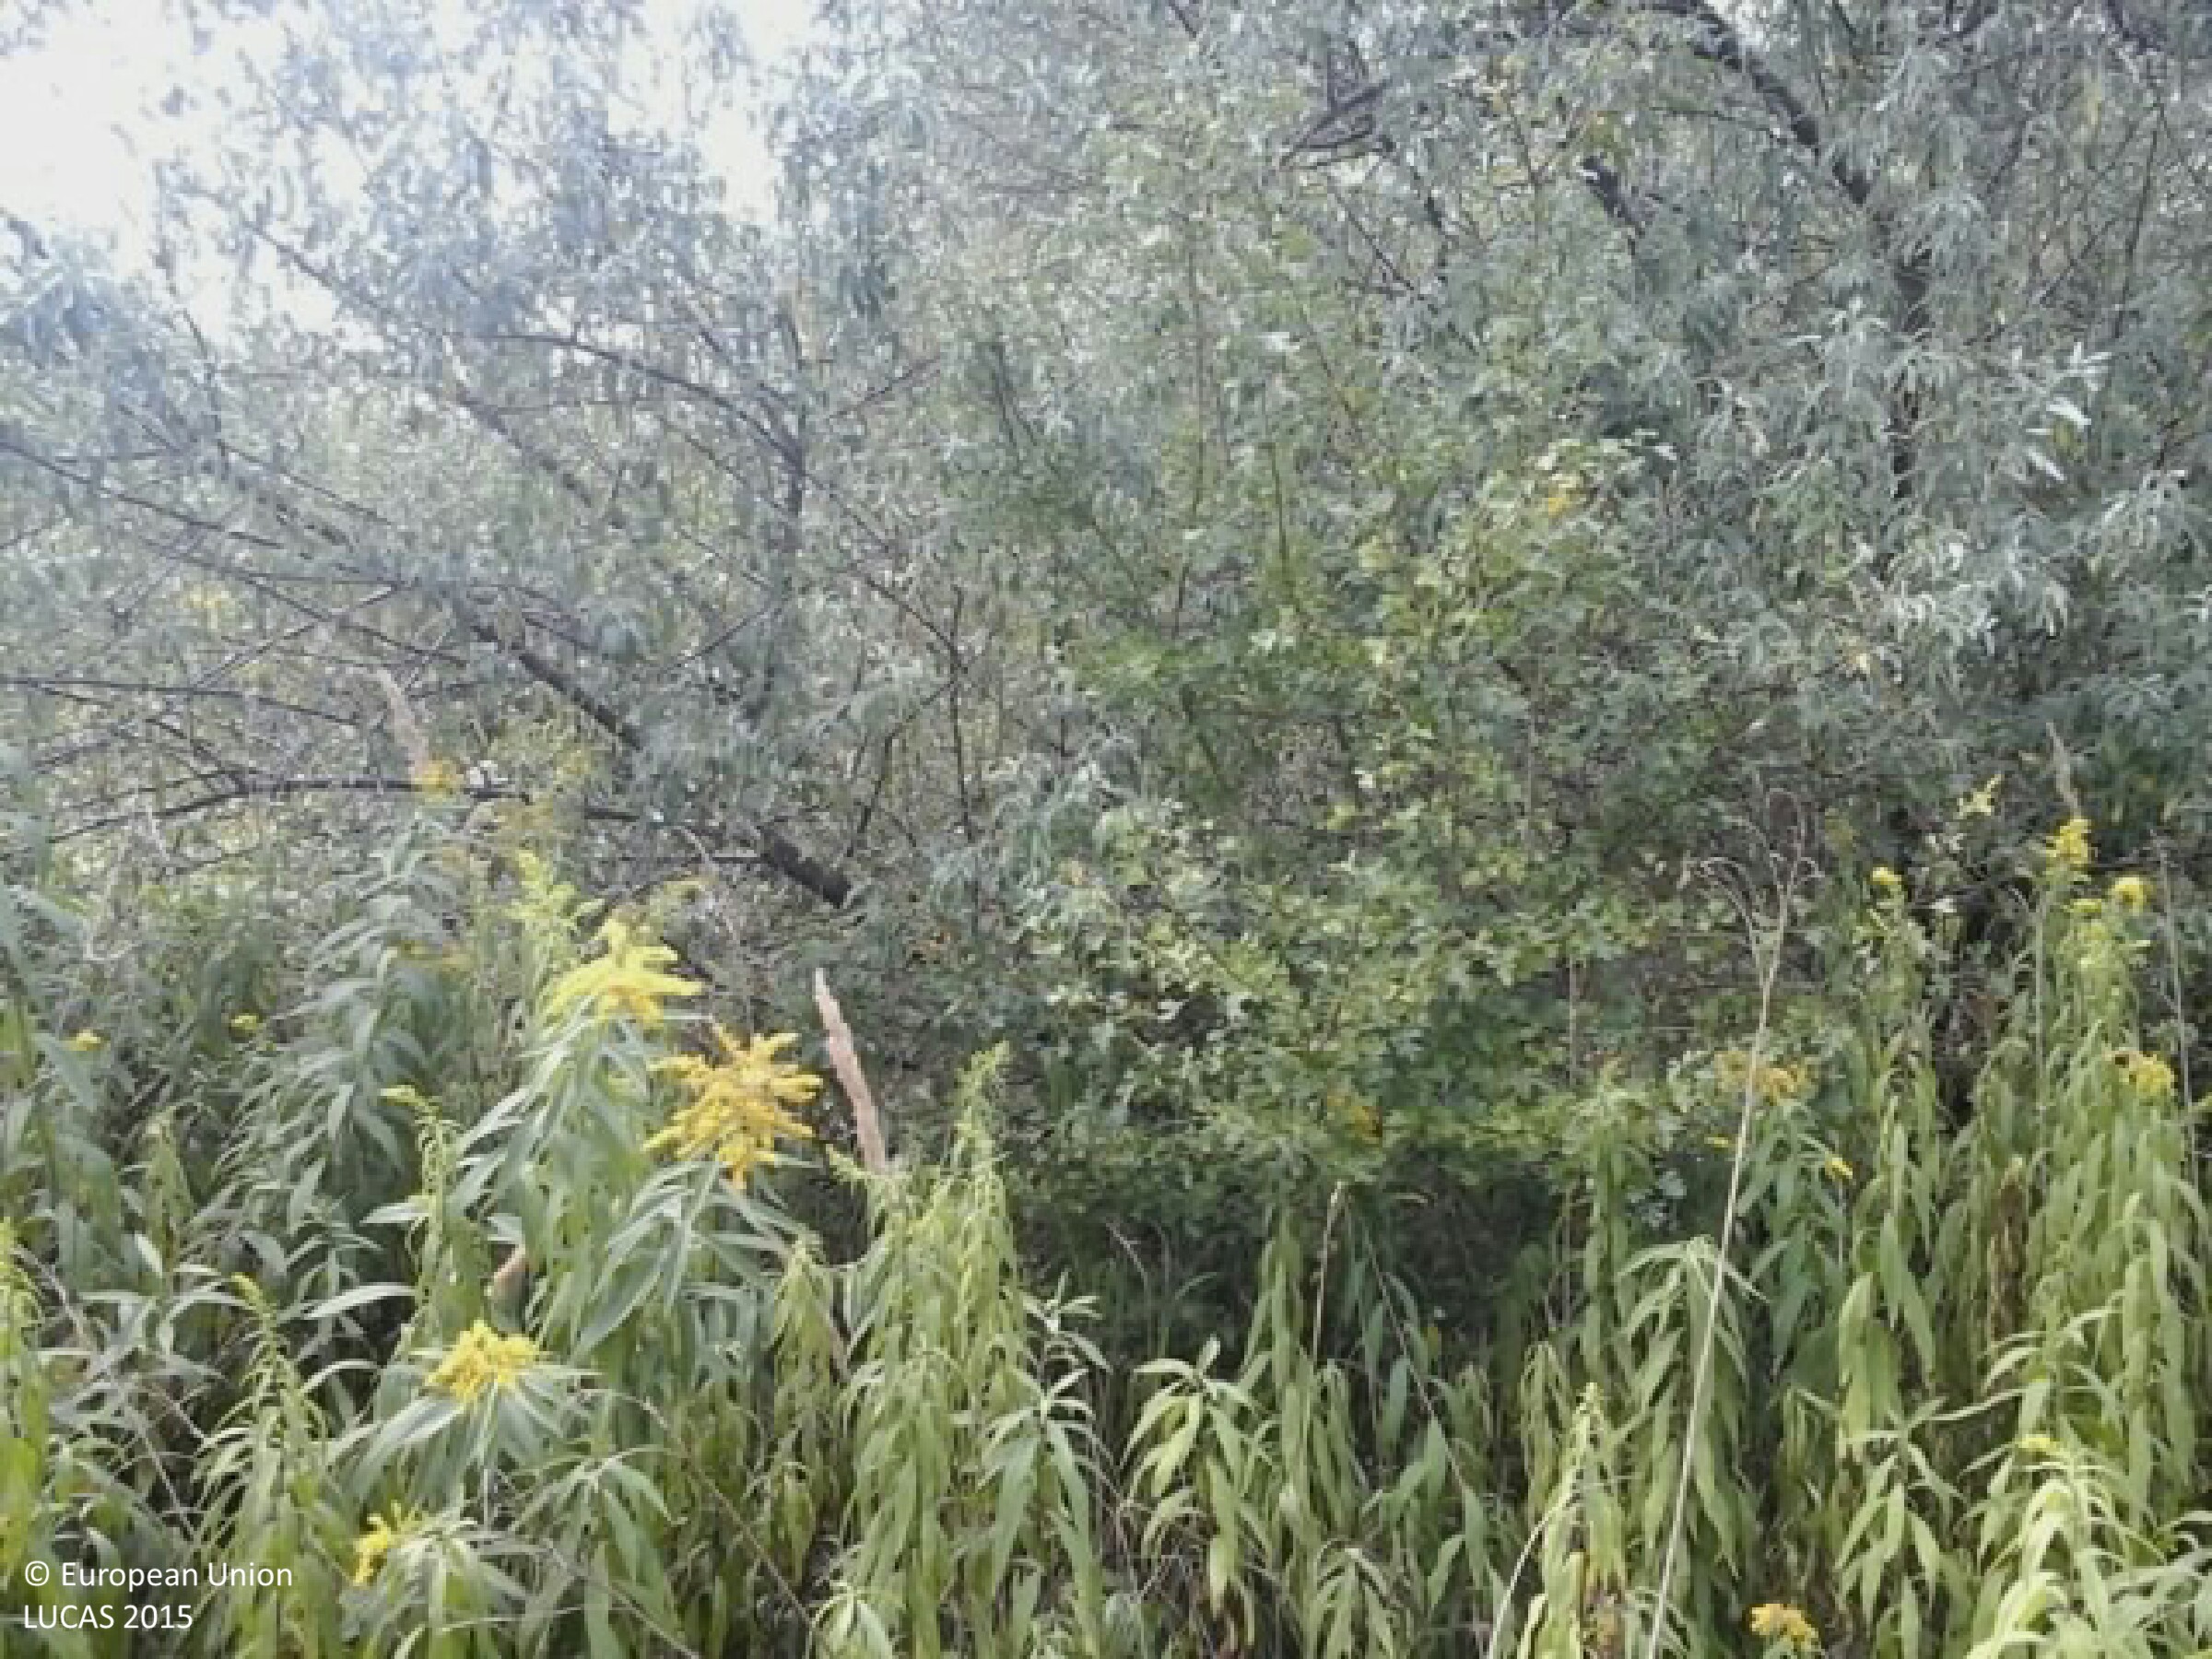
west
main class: Grassland
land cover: Spontaneously vegetated surfaces
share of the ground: > 75 %
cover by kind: herbaceous plants 95 %, shrubs 5 %
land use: Fallow land
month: August
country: HU
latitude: 46.8061
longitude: 18.3050
